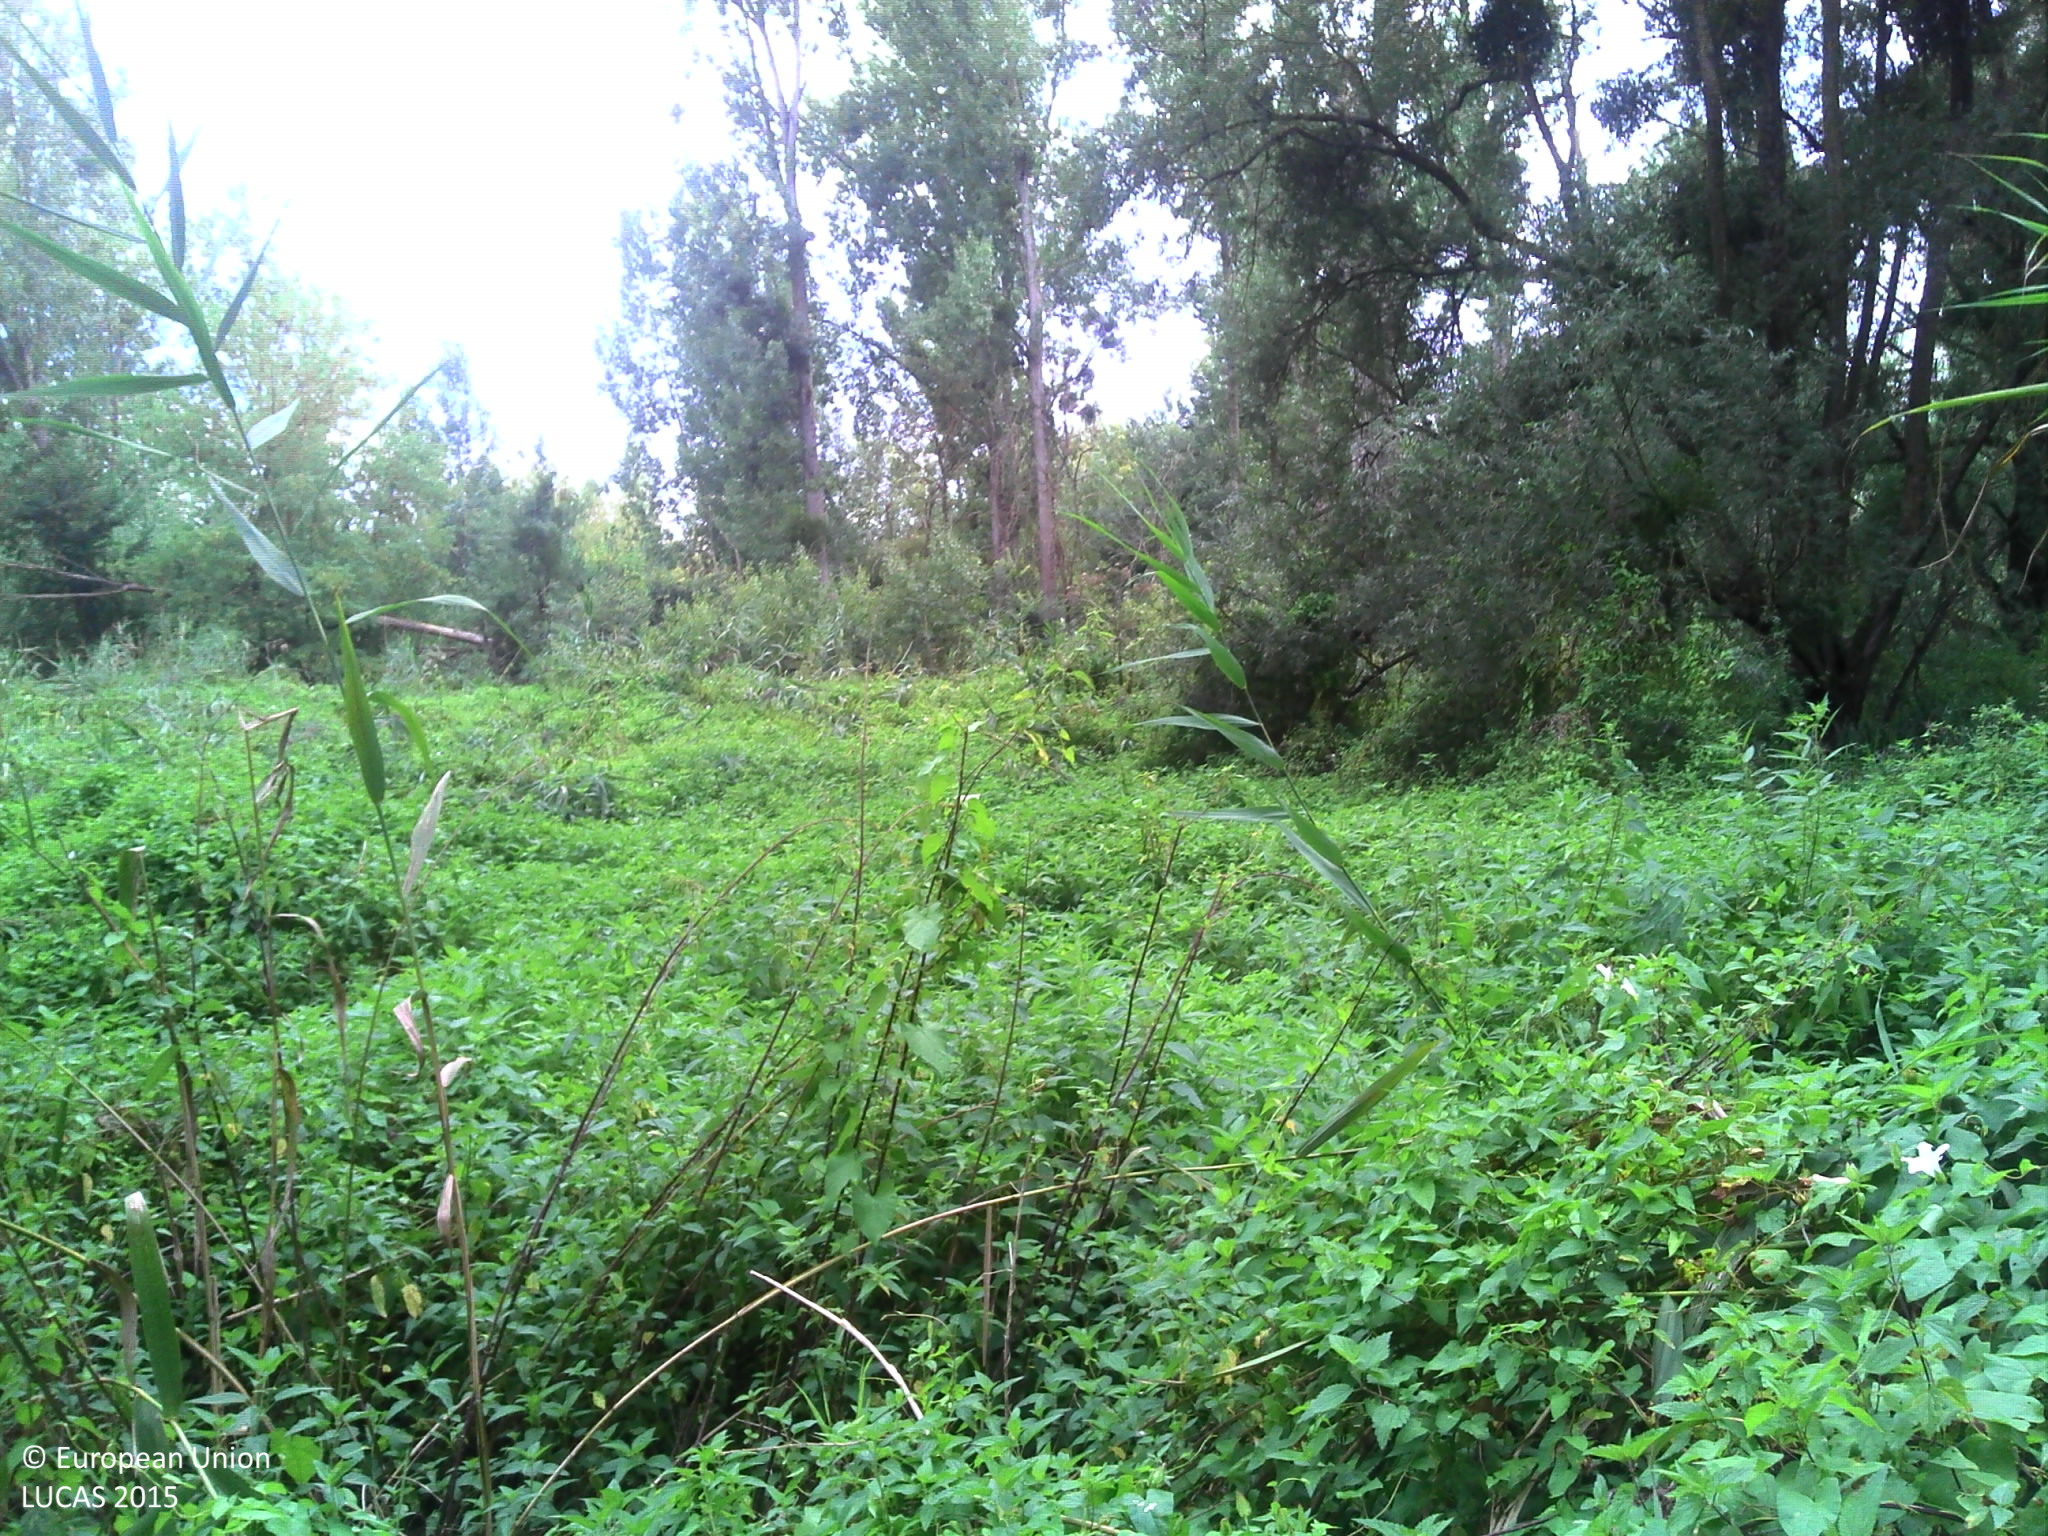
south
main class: Grassland
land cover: Spontaneously vegetated surfaces
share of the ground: > 75 %
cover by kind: herbaceous plants 100 %
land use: Semi-natural and natural areas not in use
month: September
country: FR
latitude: 46.8593
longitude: 1.4490
